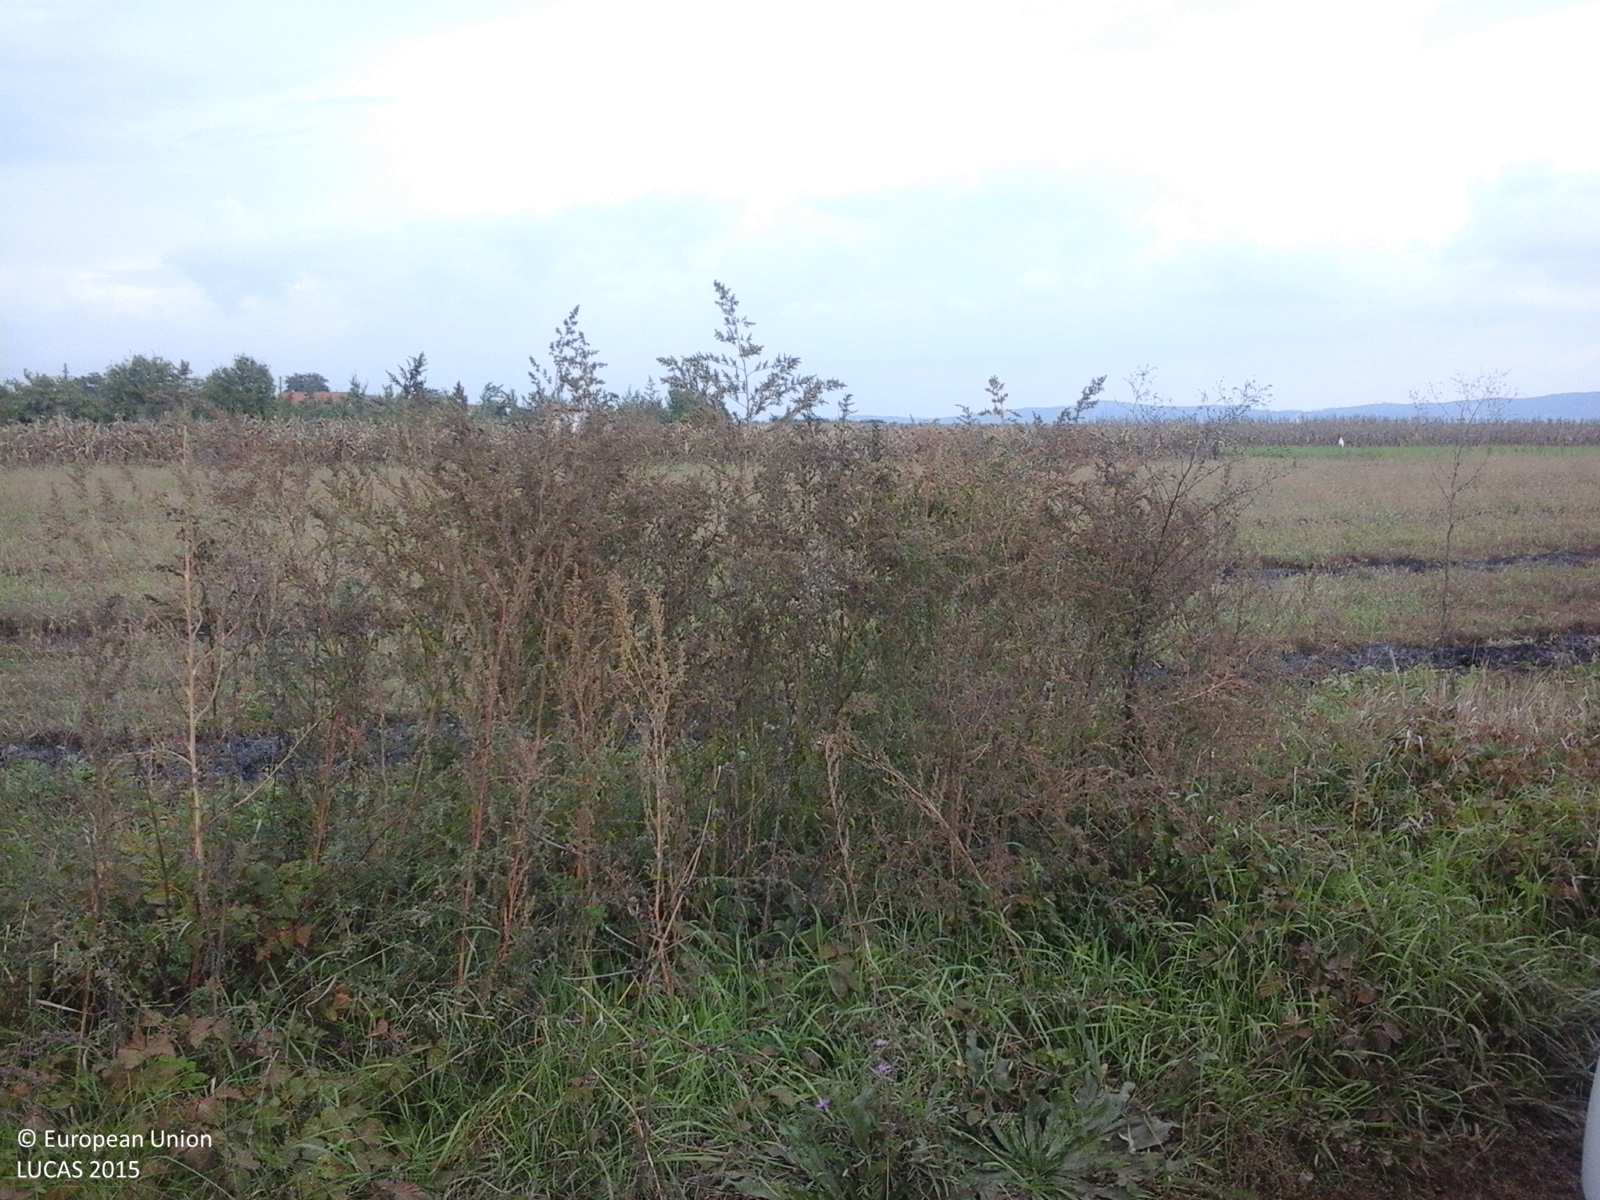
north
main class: Cropland
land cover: Maize
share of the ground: > 75 %
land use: Agriculture (excluding fallow land and kitchen gardens)
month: October
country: RO
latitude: 46.4800
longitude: 23.8948
